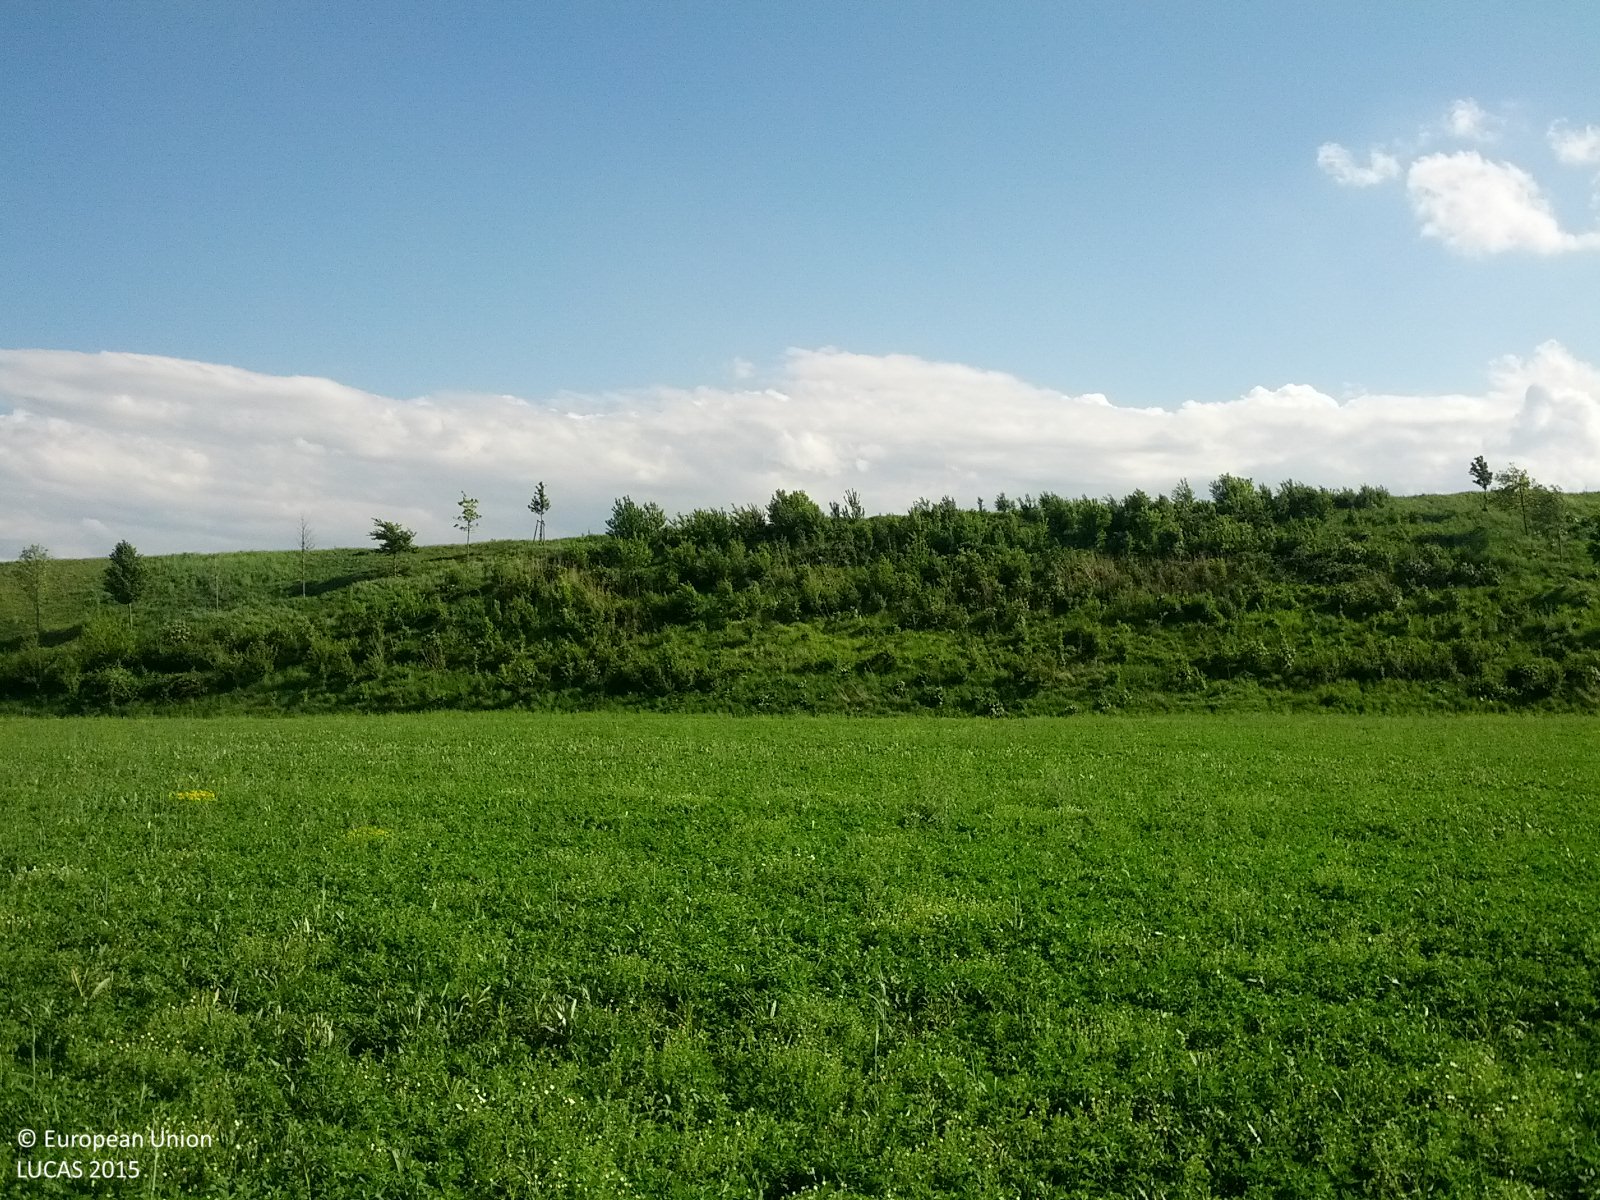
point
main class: Cropland
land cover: Lucerne
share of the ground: 50 - 75 %
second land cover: Other leguminous and mixtures for fodder
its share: 50 - 75 %
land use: Agriculture (excluding fallow land and kitchen gardens)
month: May
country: AT
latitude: 48.1254
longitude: 16.4405
